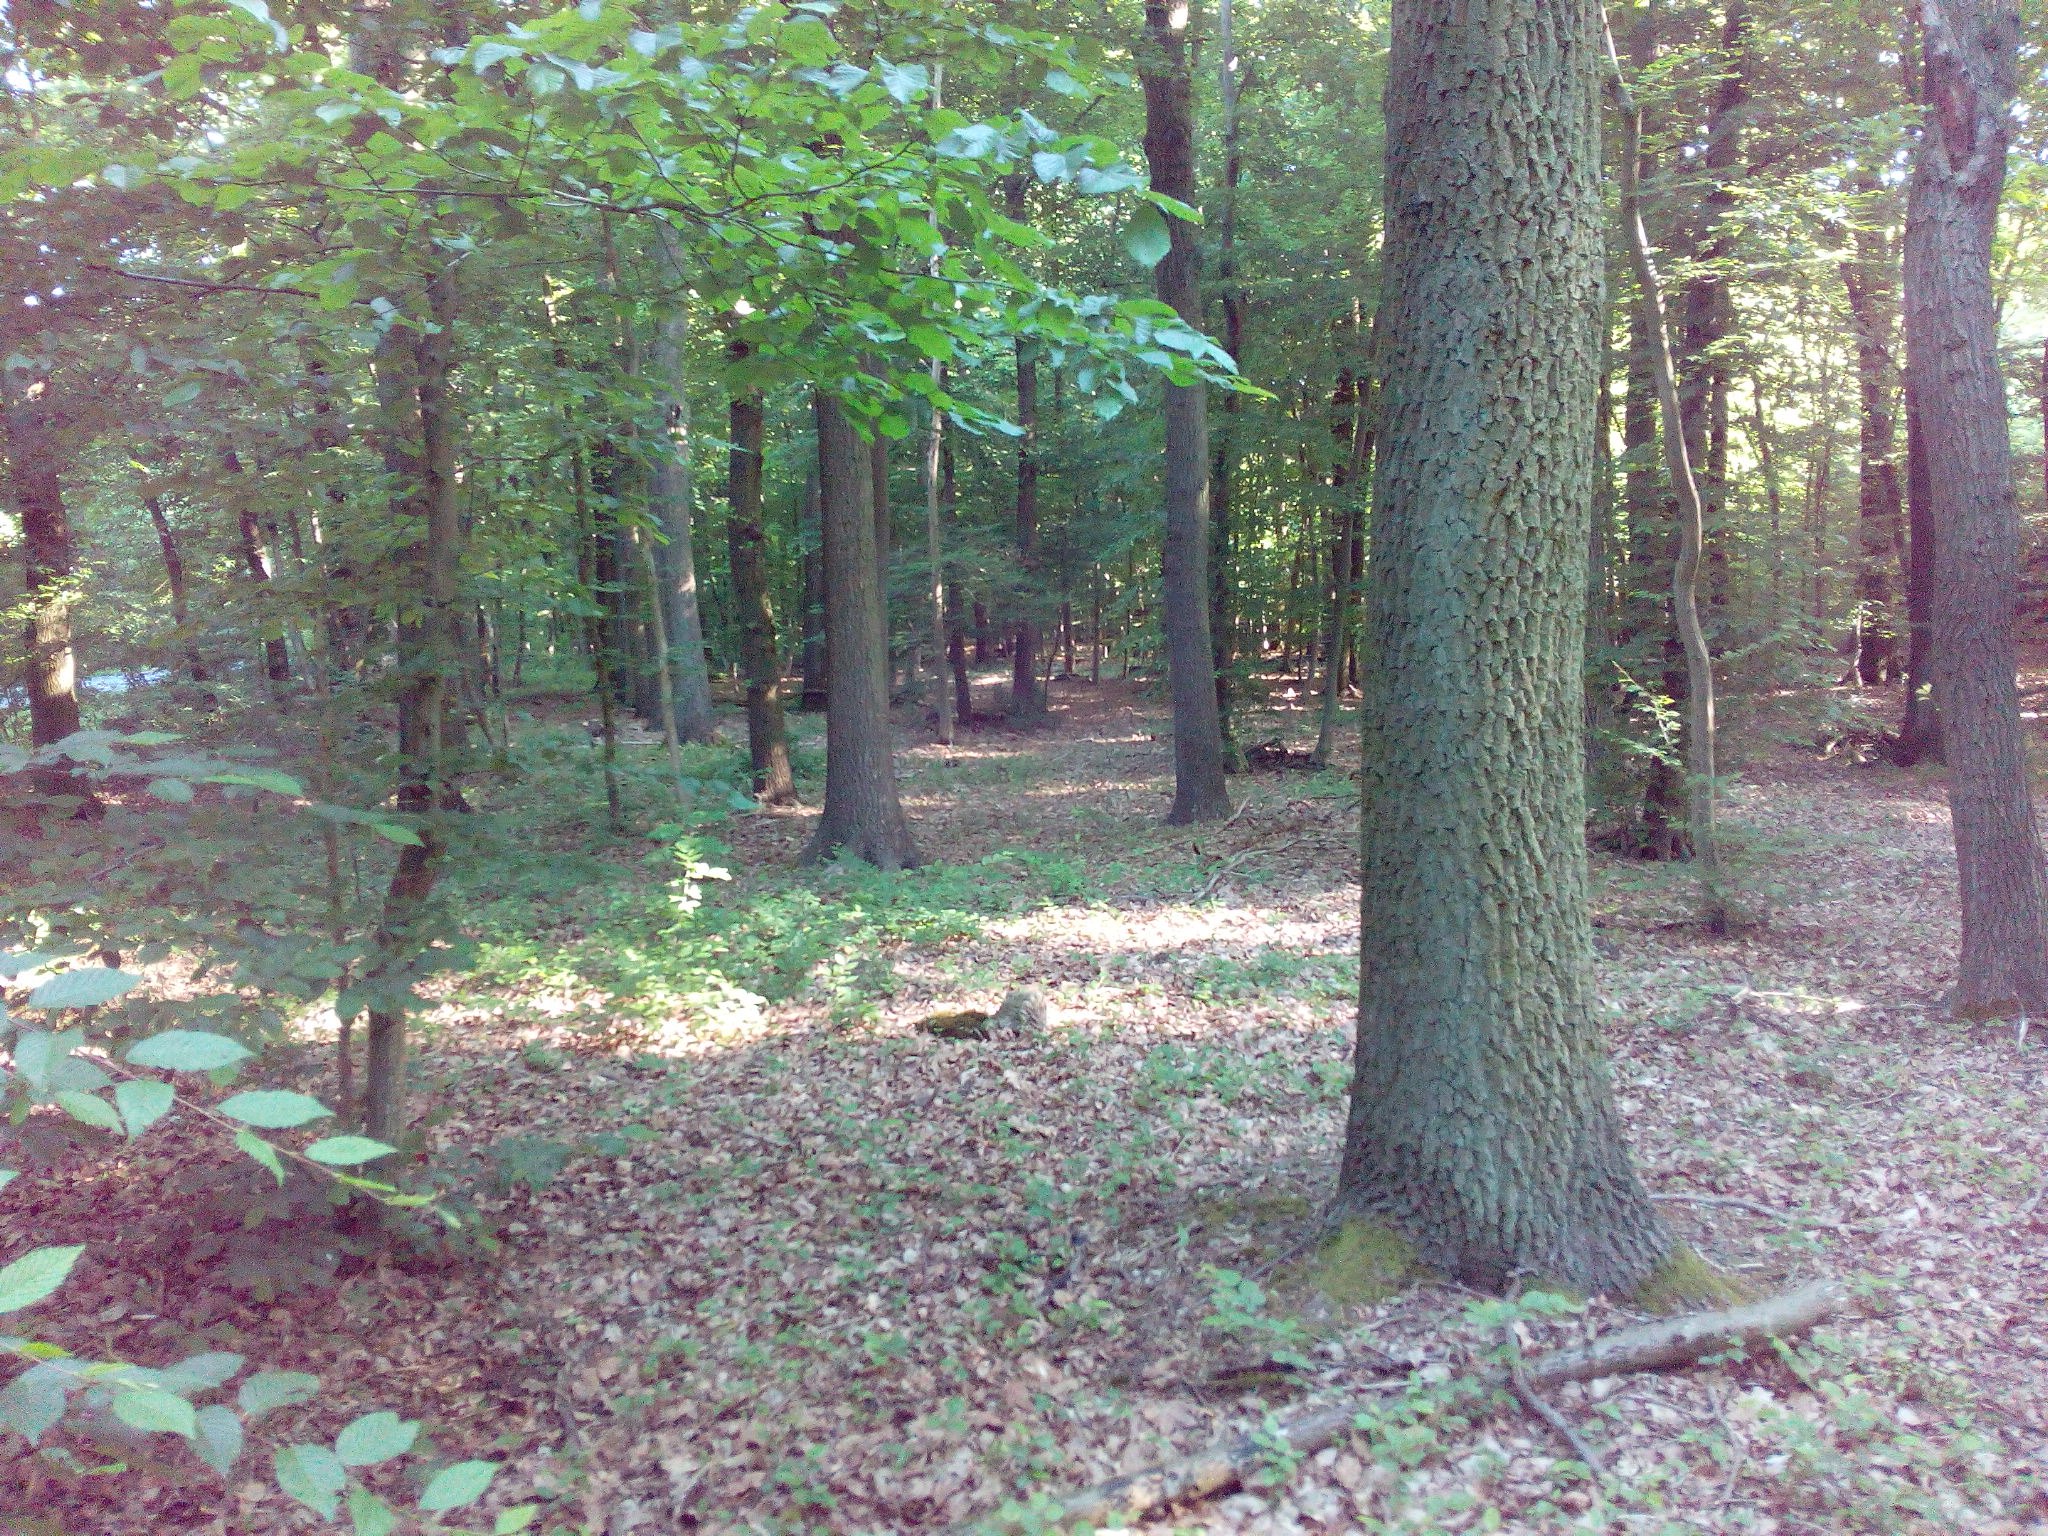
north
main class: Woodland
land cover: Broadleaved woodland
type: hemiboreal forest and nemoral coniferous forest and mixed broadleaved-coniferous forest
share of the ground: > 75 %
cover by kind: broadleaved forest trees 90 %, shrubs 5 %, herbaceous plants 5 %
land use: Forestry
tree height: > 5 m
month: June
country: DE
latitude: 52.3055
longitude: 9.8974
